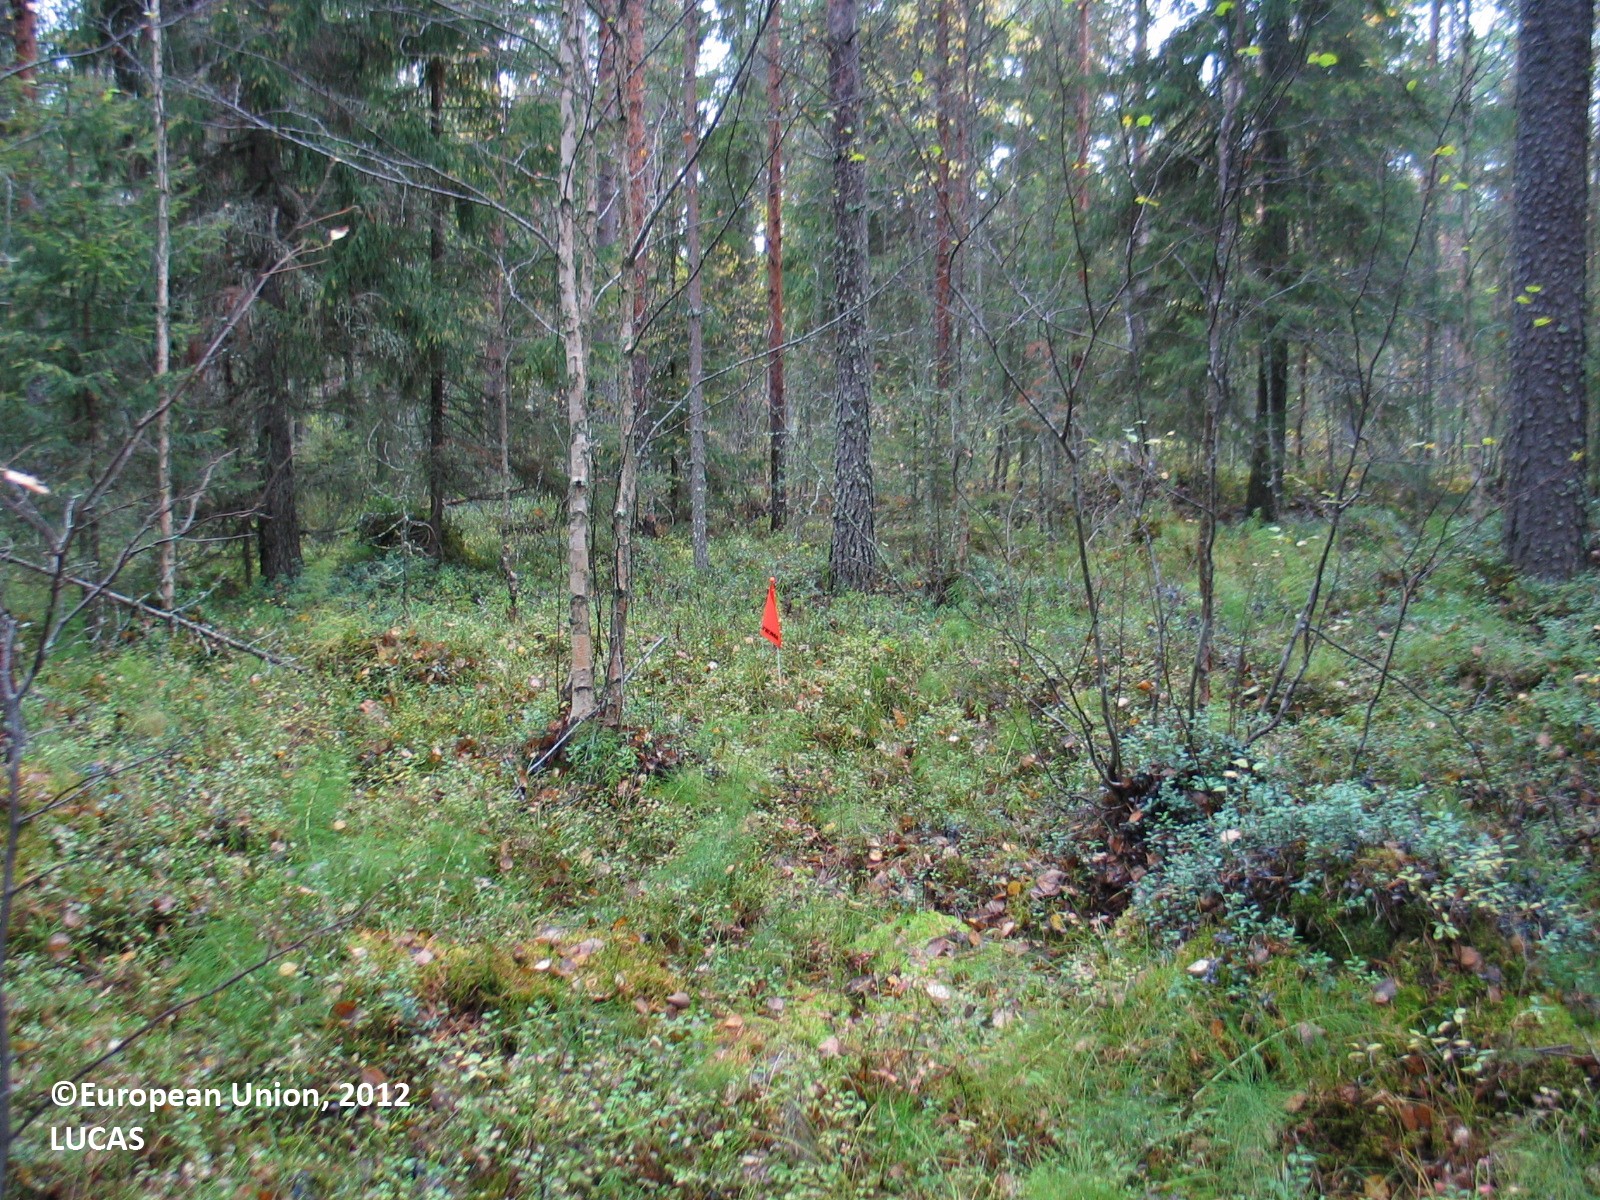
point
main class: Woodland
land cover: Pine dominated coniferous woodland
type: mire and swamp forests
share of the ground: 50 - 75 %
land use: Forestry
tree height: > 5 m
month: September
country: FI
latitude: 65.3824
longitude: 25.5490
